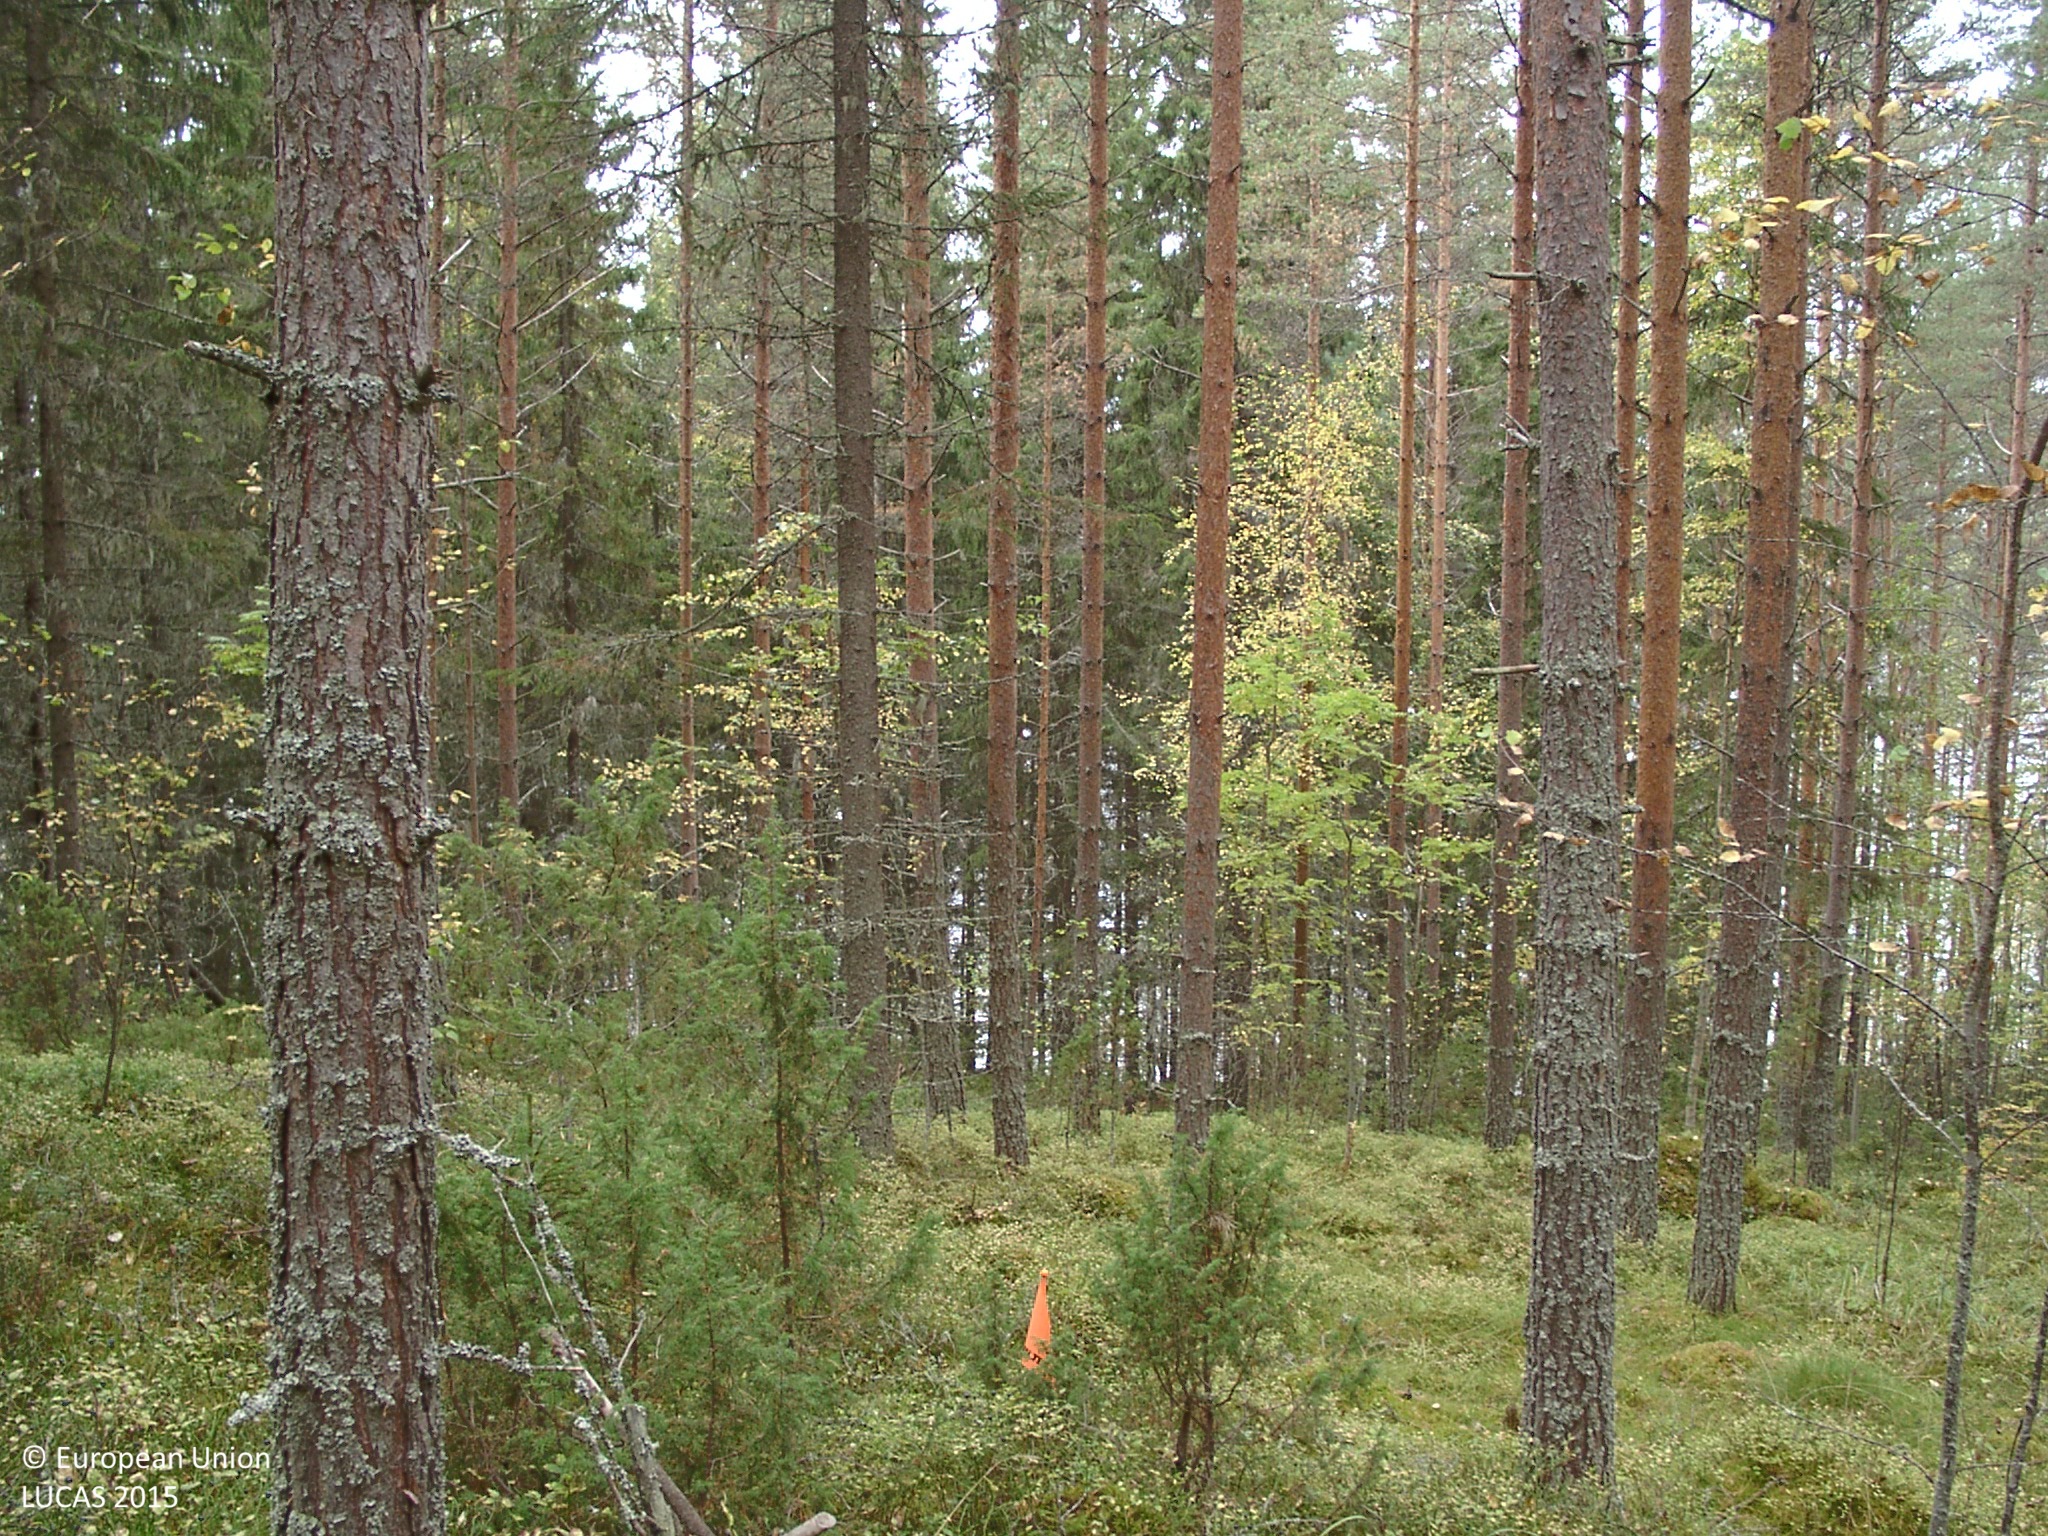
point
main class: Woodland
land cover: Pine dominated mixed woodland
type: boreal forest
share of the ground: 50 - 75 %
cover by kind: coniferous forest trees 50 %, broadleaved forest trees 20 %, shrubs 15 %, lichens and mosses 15 %
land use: Forestry
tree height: > 5 m
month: September
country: FI
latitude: 62.6973
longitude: 25.4088
